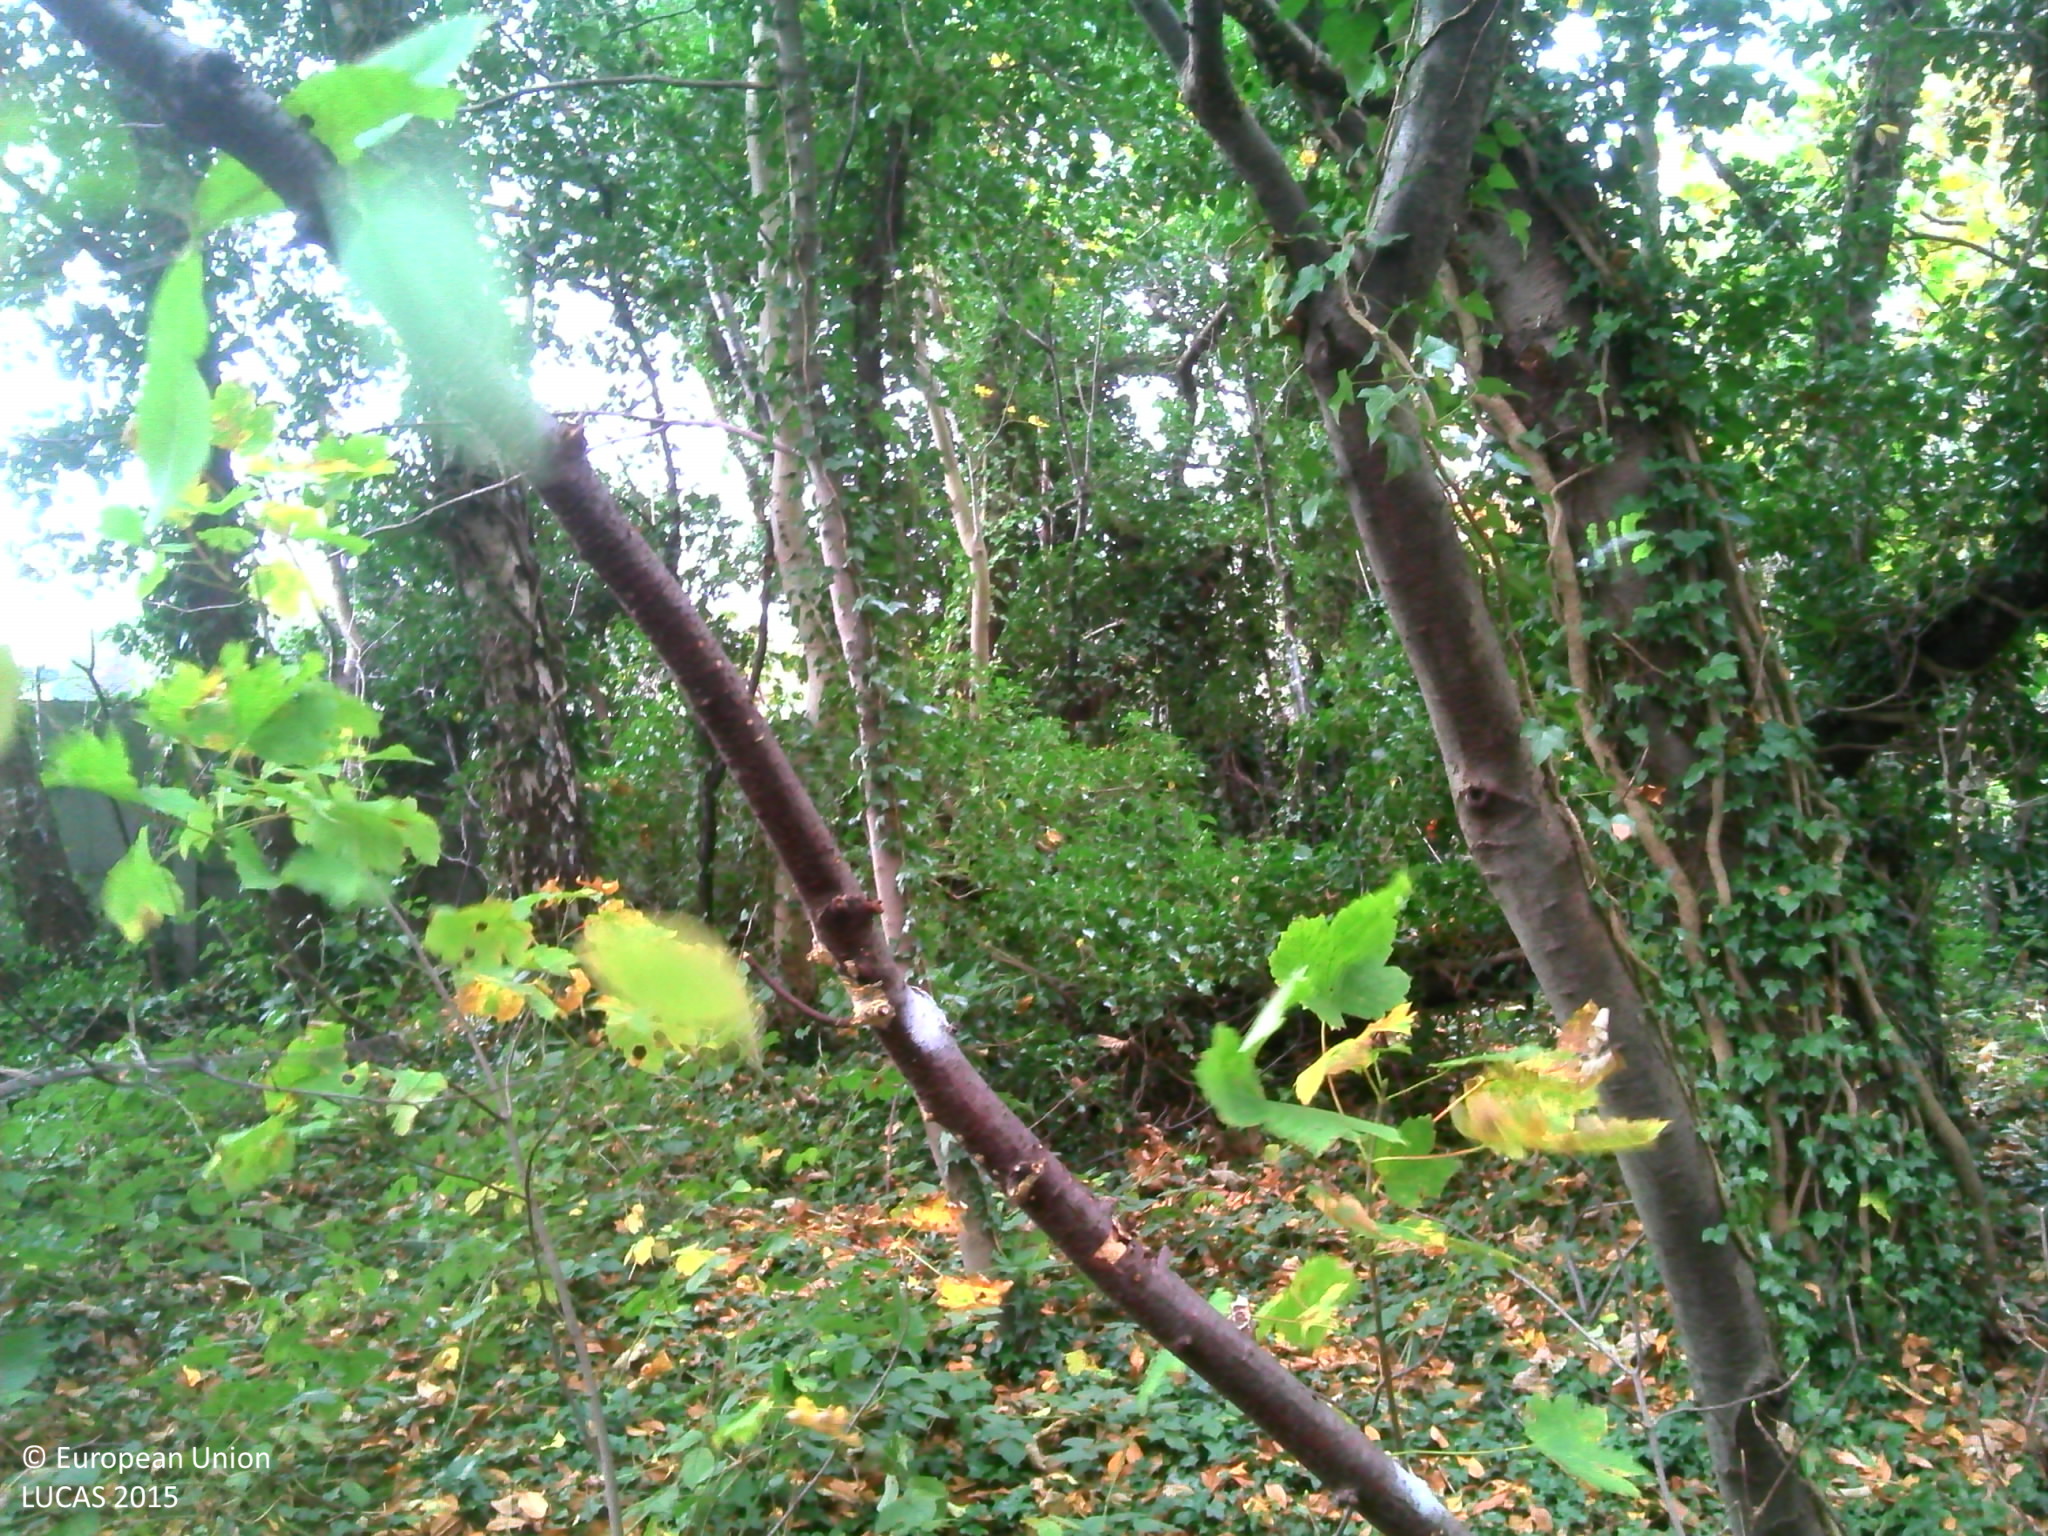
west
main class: Woodland
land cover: Broadleaved woodland
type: mesophytic deciduous forest
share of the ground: > 75 %
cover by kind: broadleaved forest trees 95 %, herbaceous plants 5 %
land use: Forestry
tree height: > 5 m
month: November
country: BE
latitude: 51.0071
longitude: 4.5088
